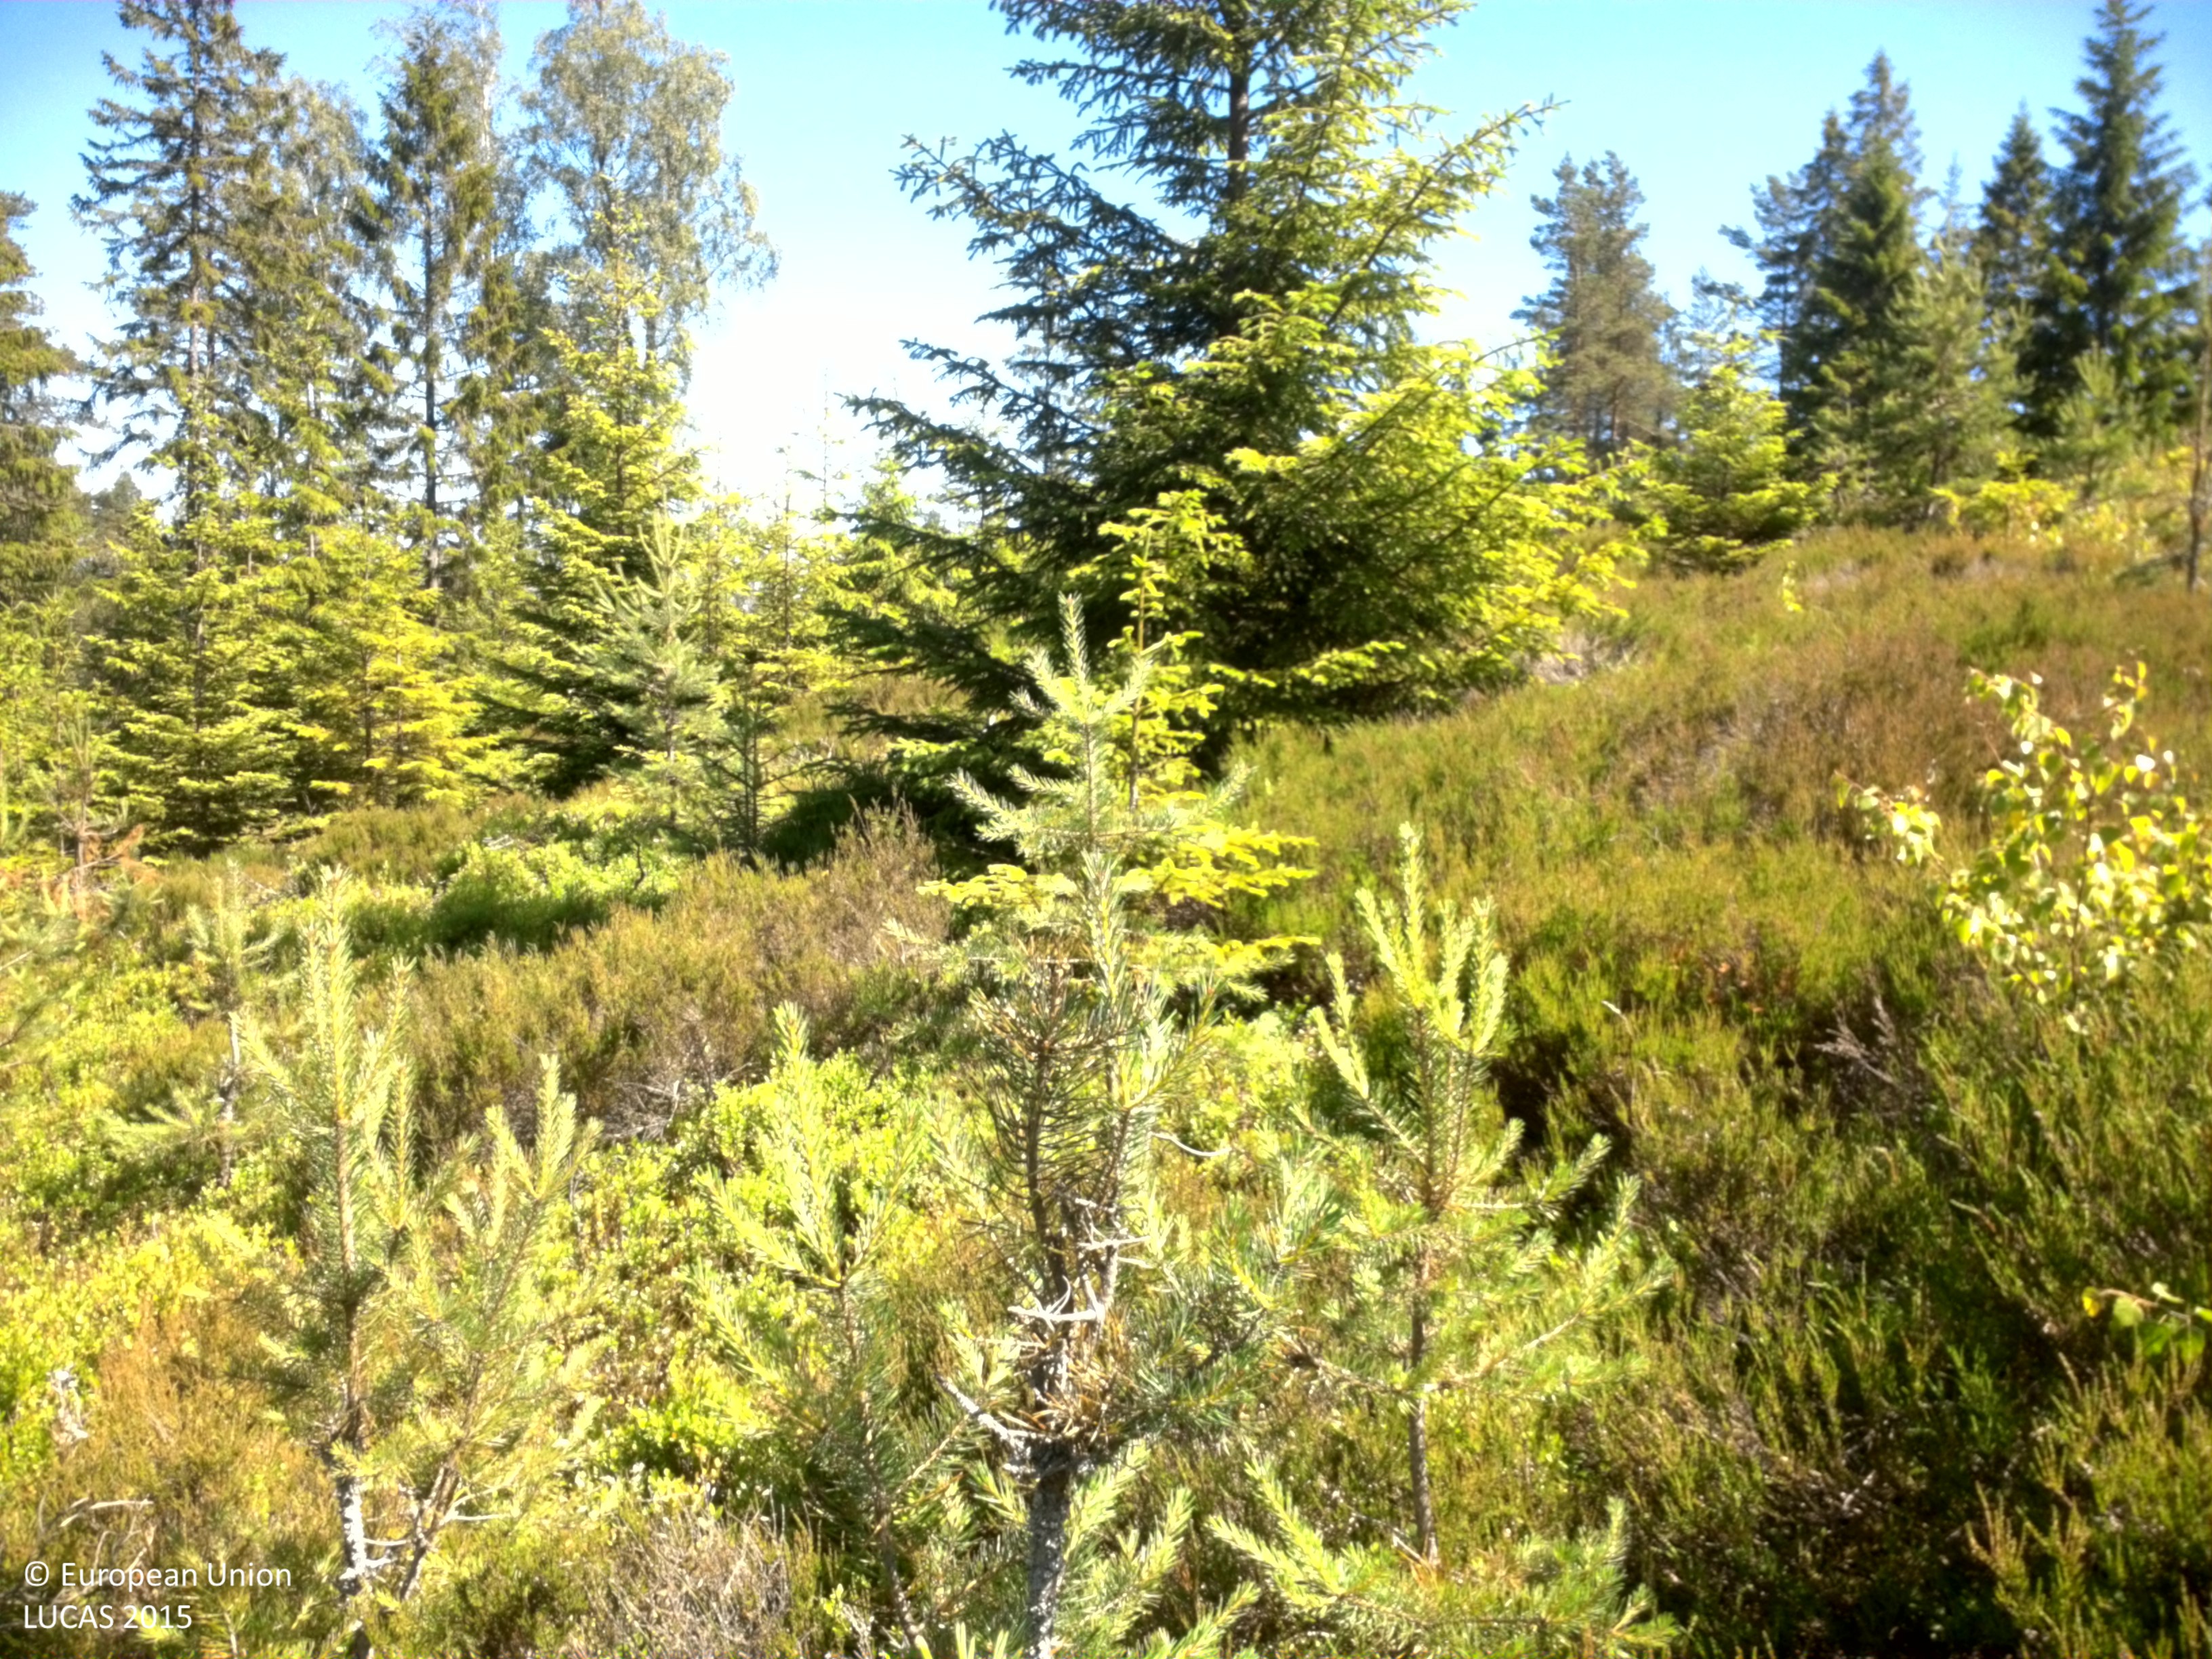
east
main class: Woodland
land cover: Other mixed woodland
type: boreal forest
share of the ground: 25 - 50 %
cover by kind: shrubs 30 %, coniferous forest trees 25 %, herbaceous plants 25 %, broadleaved forest trees 15 %, lichens and mosses 5 %
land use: Forestry
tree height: > 5 m
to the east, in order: Other mixed woodland; Tracks; Other coniferous woodland; Tracks; Other coniferous woodland; Other mixed woodland; Pine dominated coniferous woodland
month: July
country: SE
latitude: 58.7306
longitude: 14.7430
